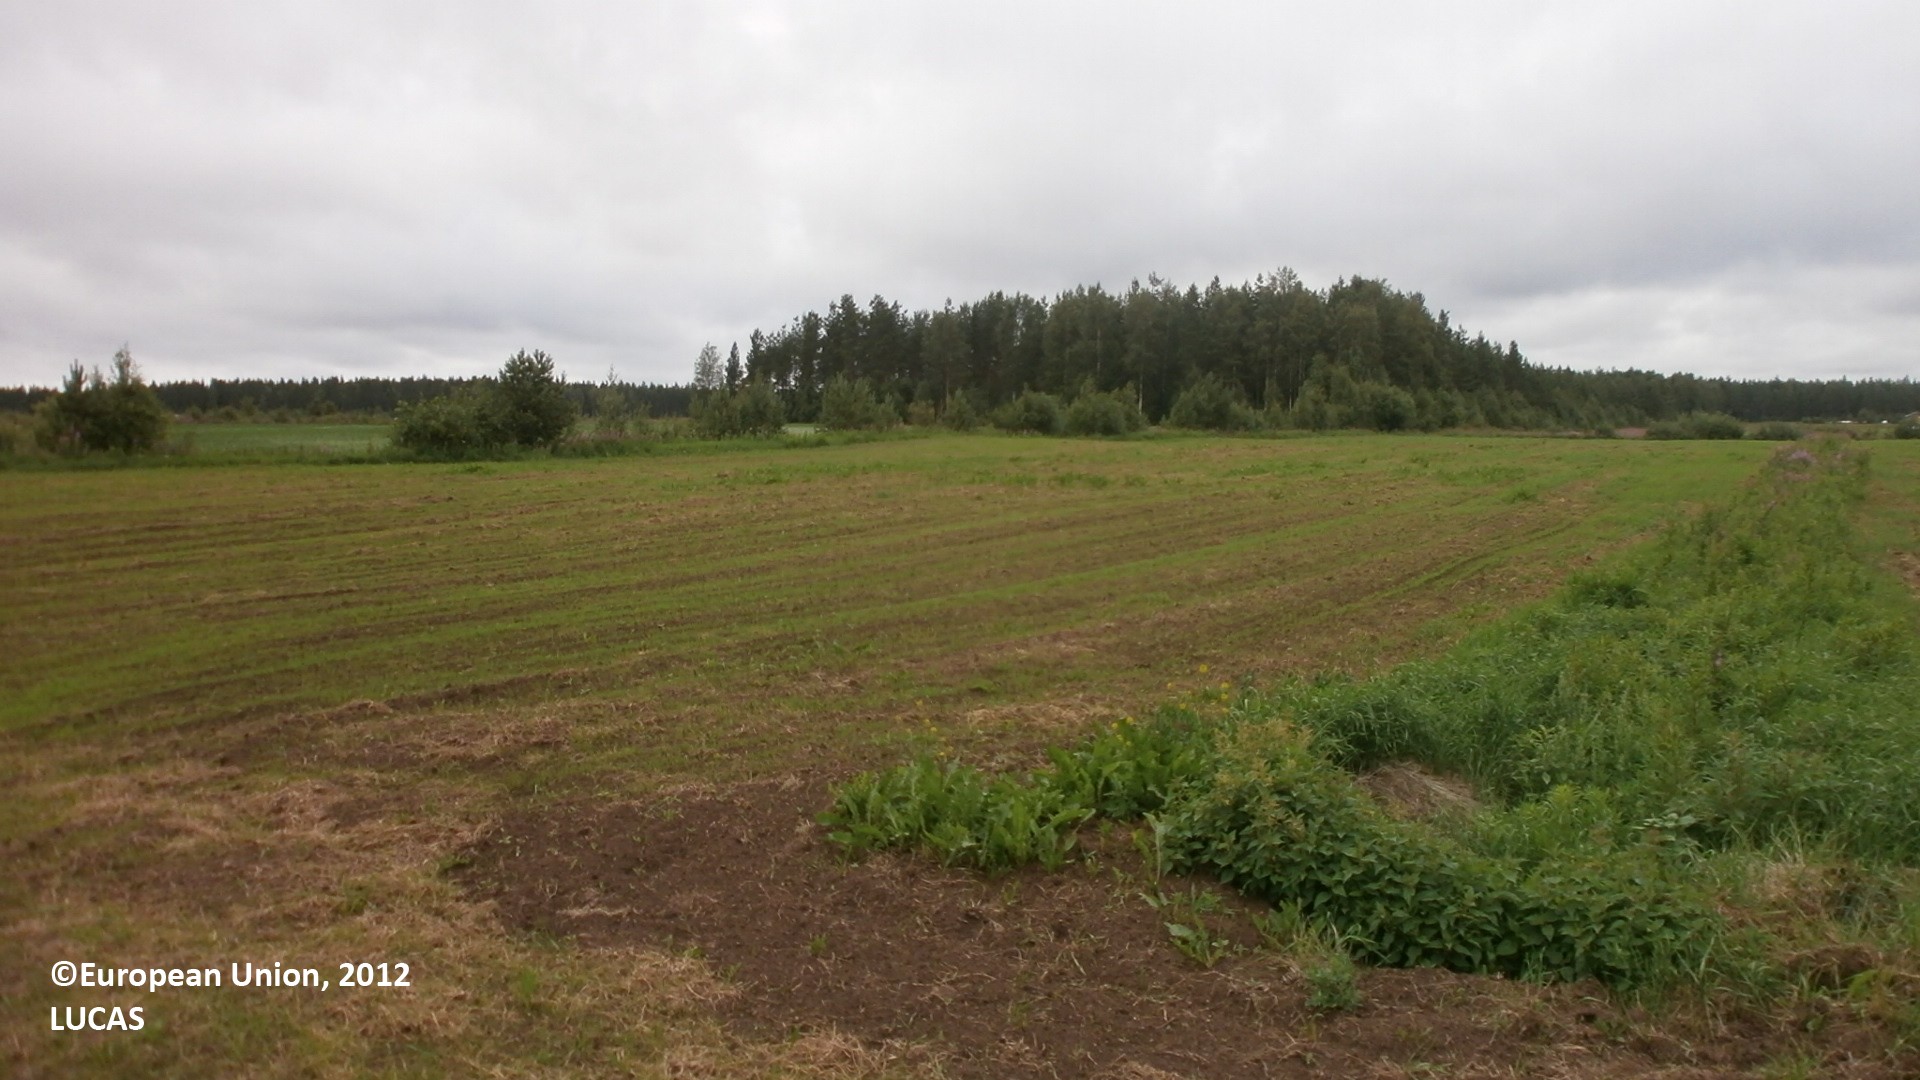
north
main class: Grassland
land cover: Grassland without tree/shrub cover
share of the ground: 10 - 25 %
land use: Agriculture (excluding fallow land and kitchen gardens)
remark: Harvested field
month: July
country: FI
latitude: 64.2670
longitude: 24.0386
